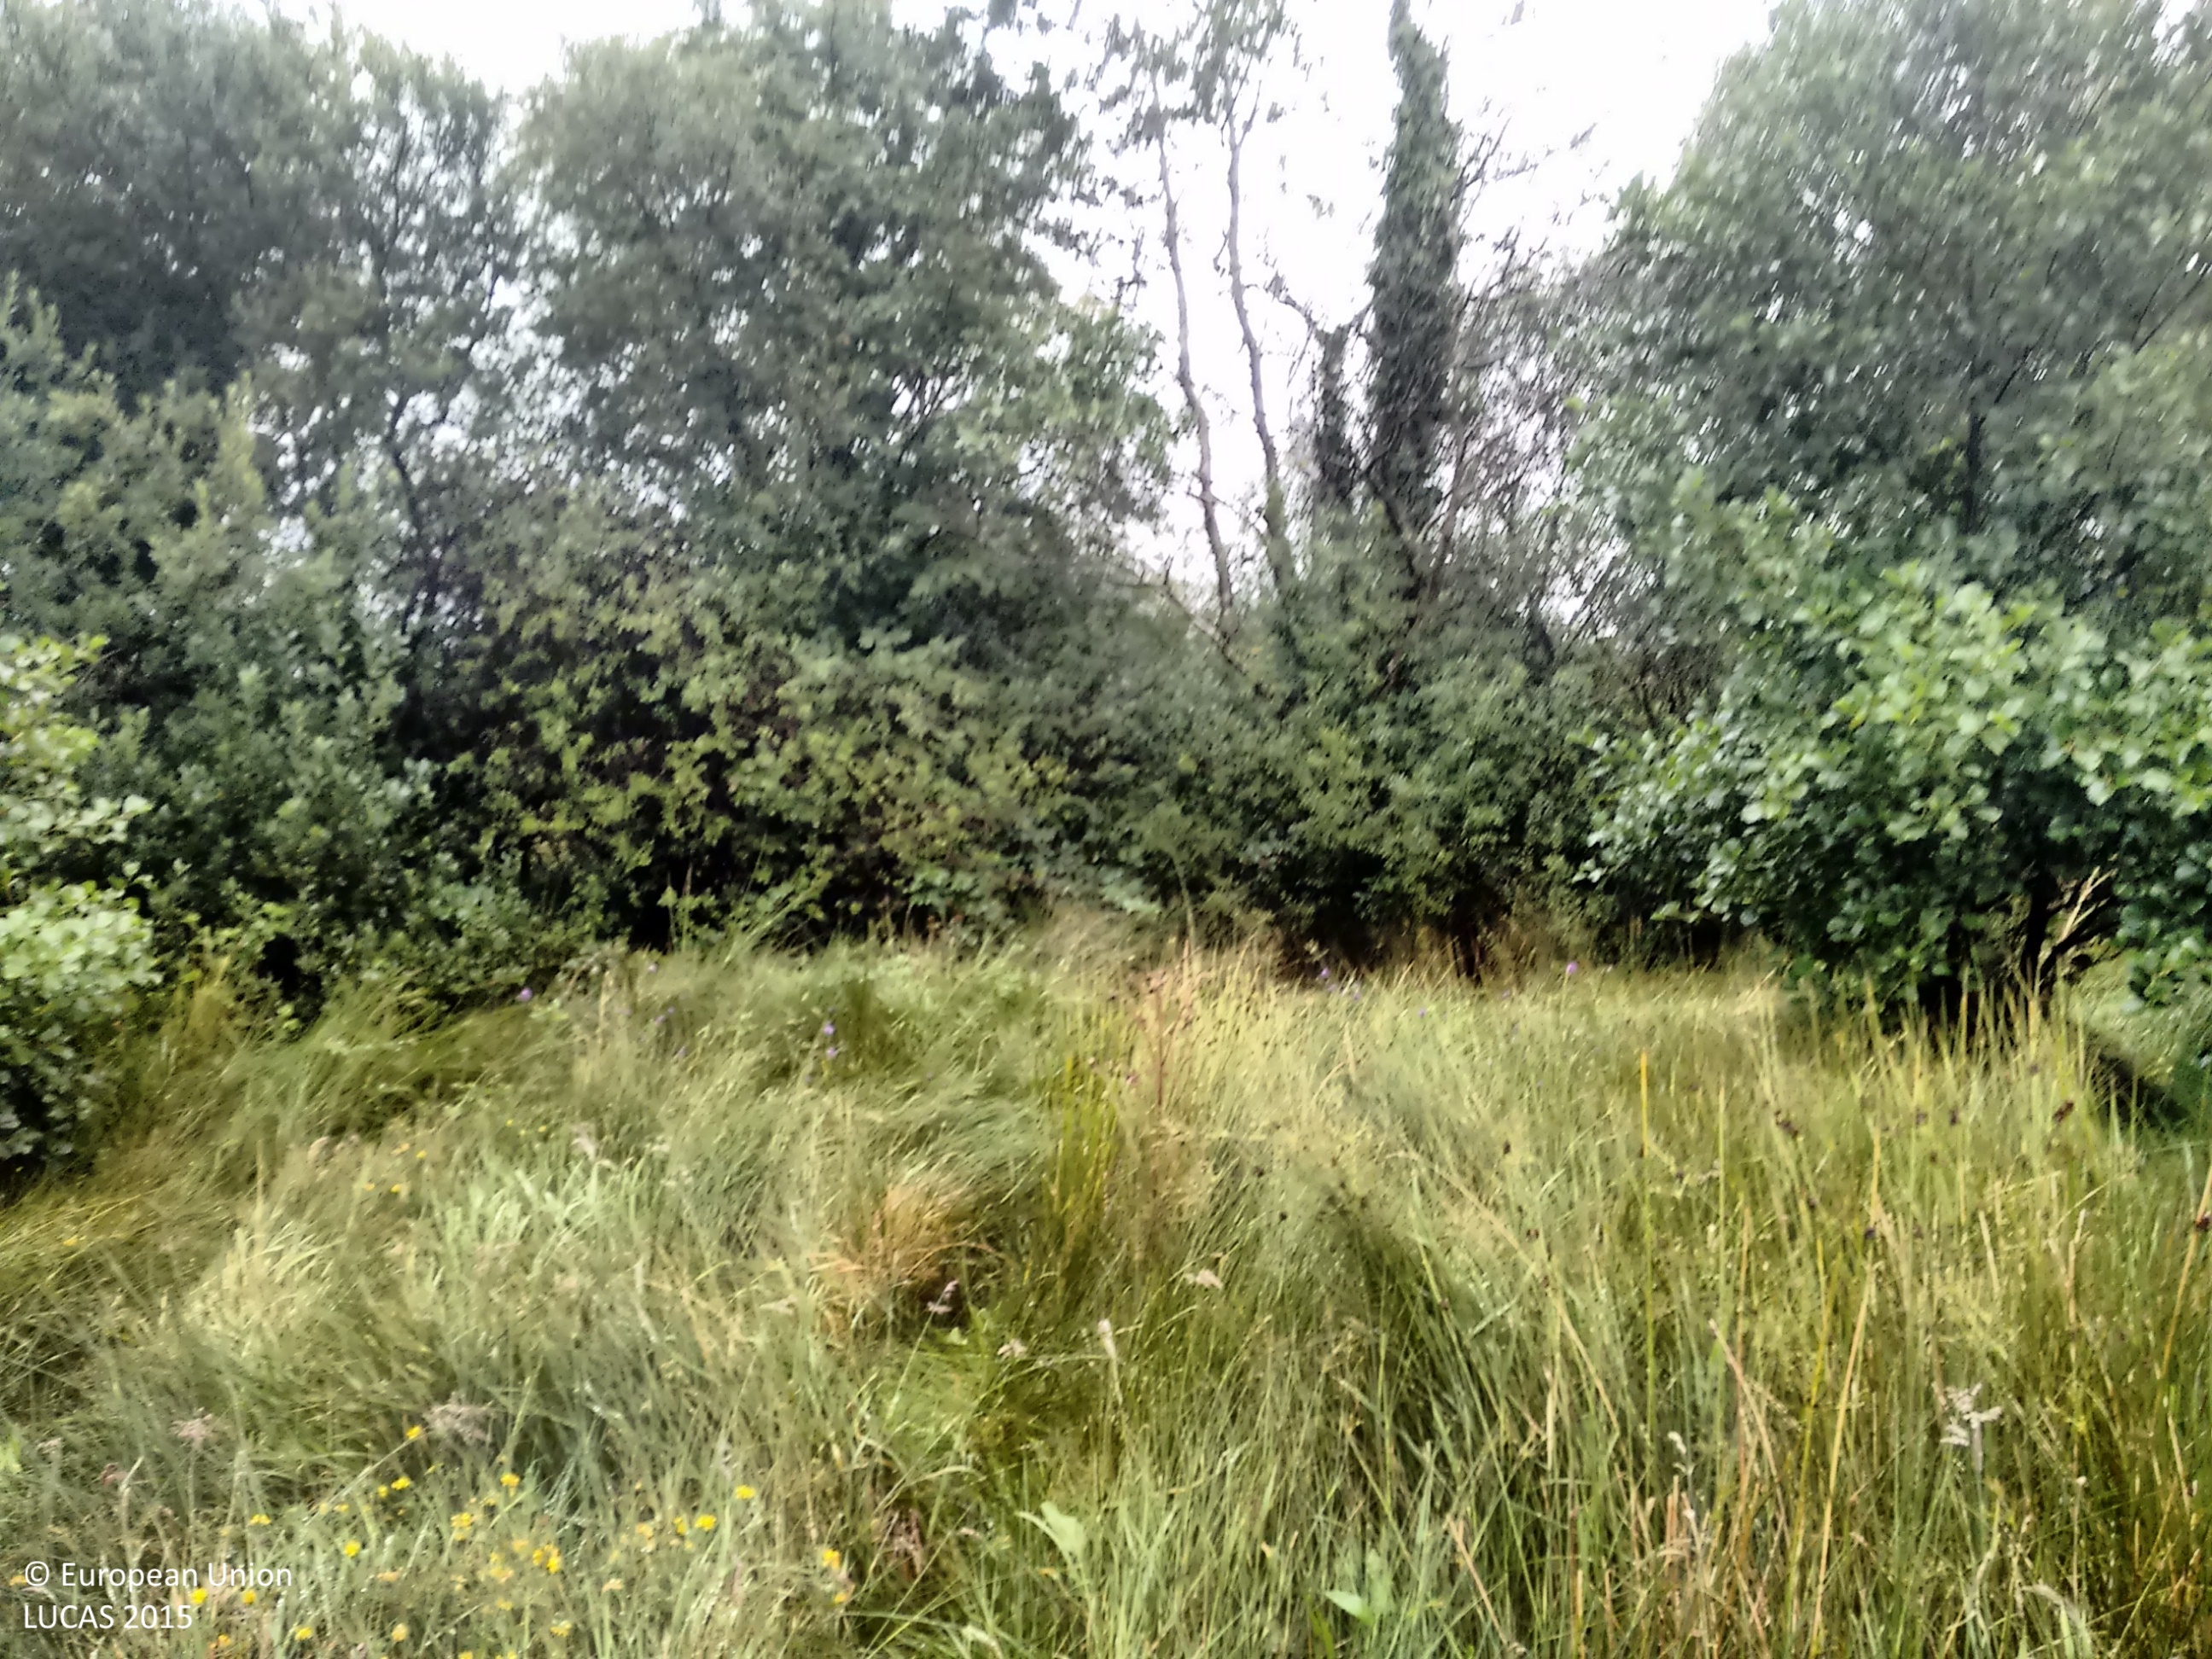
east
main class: Grassland
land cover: Grassland with sparse tree/shrub cover
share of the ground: > 75 %
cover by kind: herbaceous plants 95 %, broadleaved forest trees 5 %
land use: Abandoned areas
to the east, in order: Grassland with sparse tree/shrub cover; Fences; Broadleaved woodland; Grassland without tree/shrub cover; Fences; Broadleaved woodland; Peatbogs; Lines of trees; Ditches and canals; Grassland with sparse tree/shrub cover; Electric lines; Grassland with sparse tree/shrub cover; Artificial constructions in urban areas
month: September
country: IE
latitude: 52.0591
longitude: -9.3478
